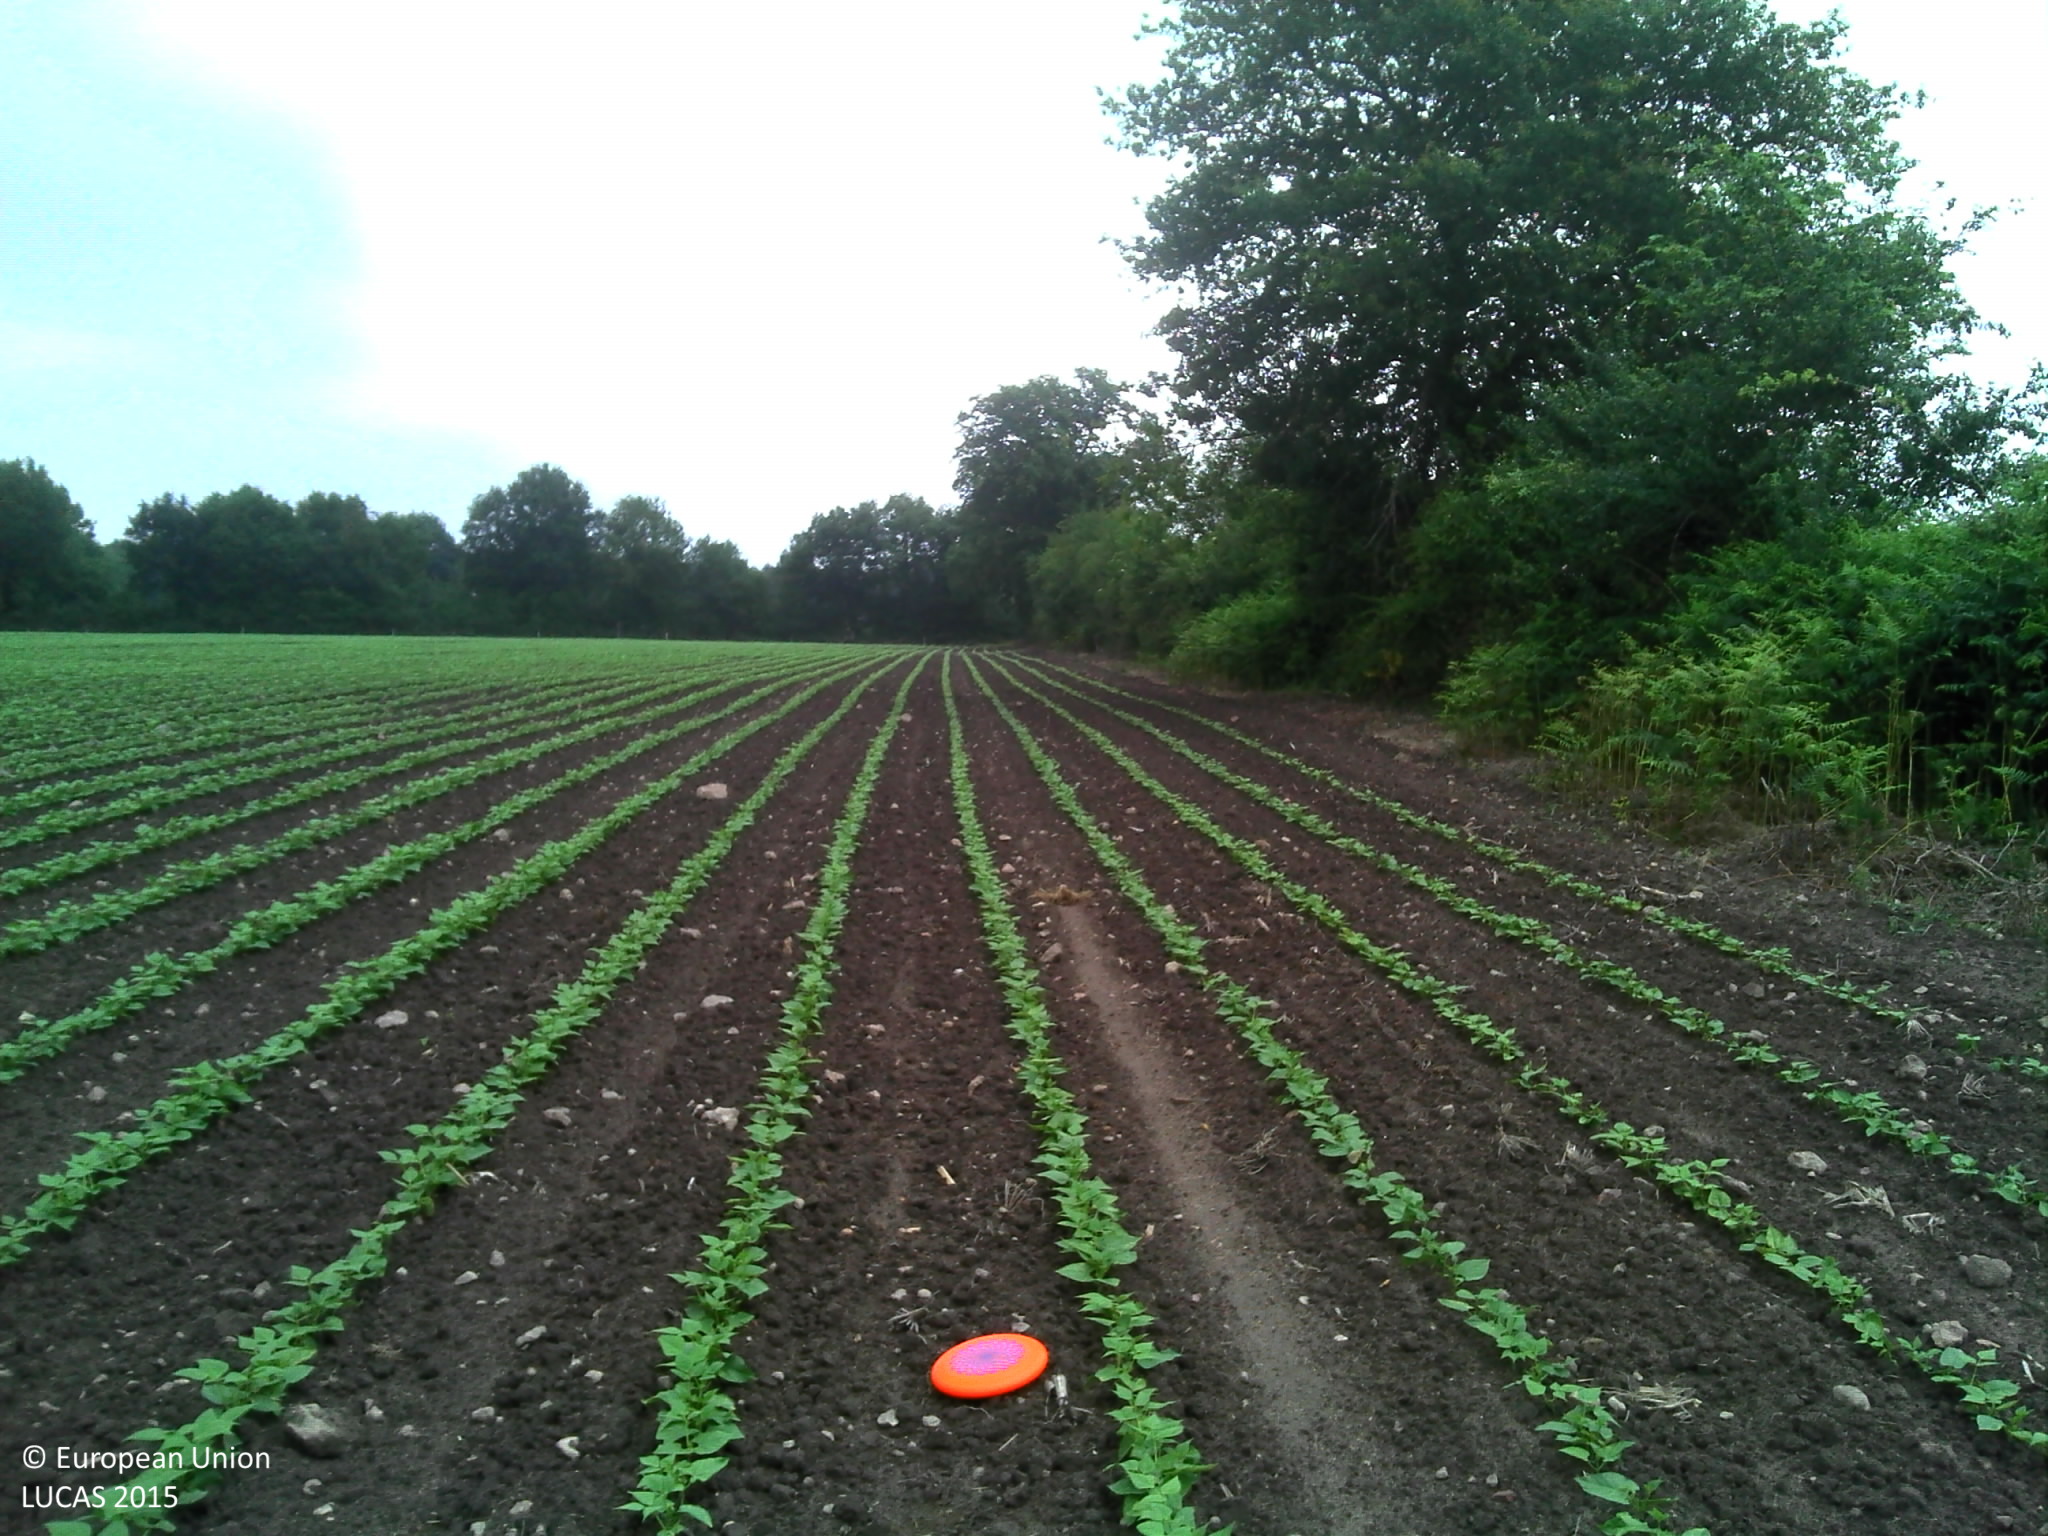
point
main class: Cropland
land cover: Dry pulses
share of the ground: 10 - 25 %
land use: Agriculture (excluding fallow land and kitchen gardens)
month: June
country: FR
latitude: 47.5140
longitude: 0.0016
